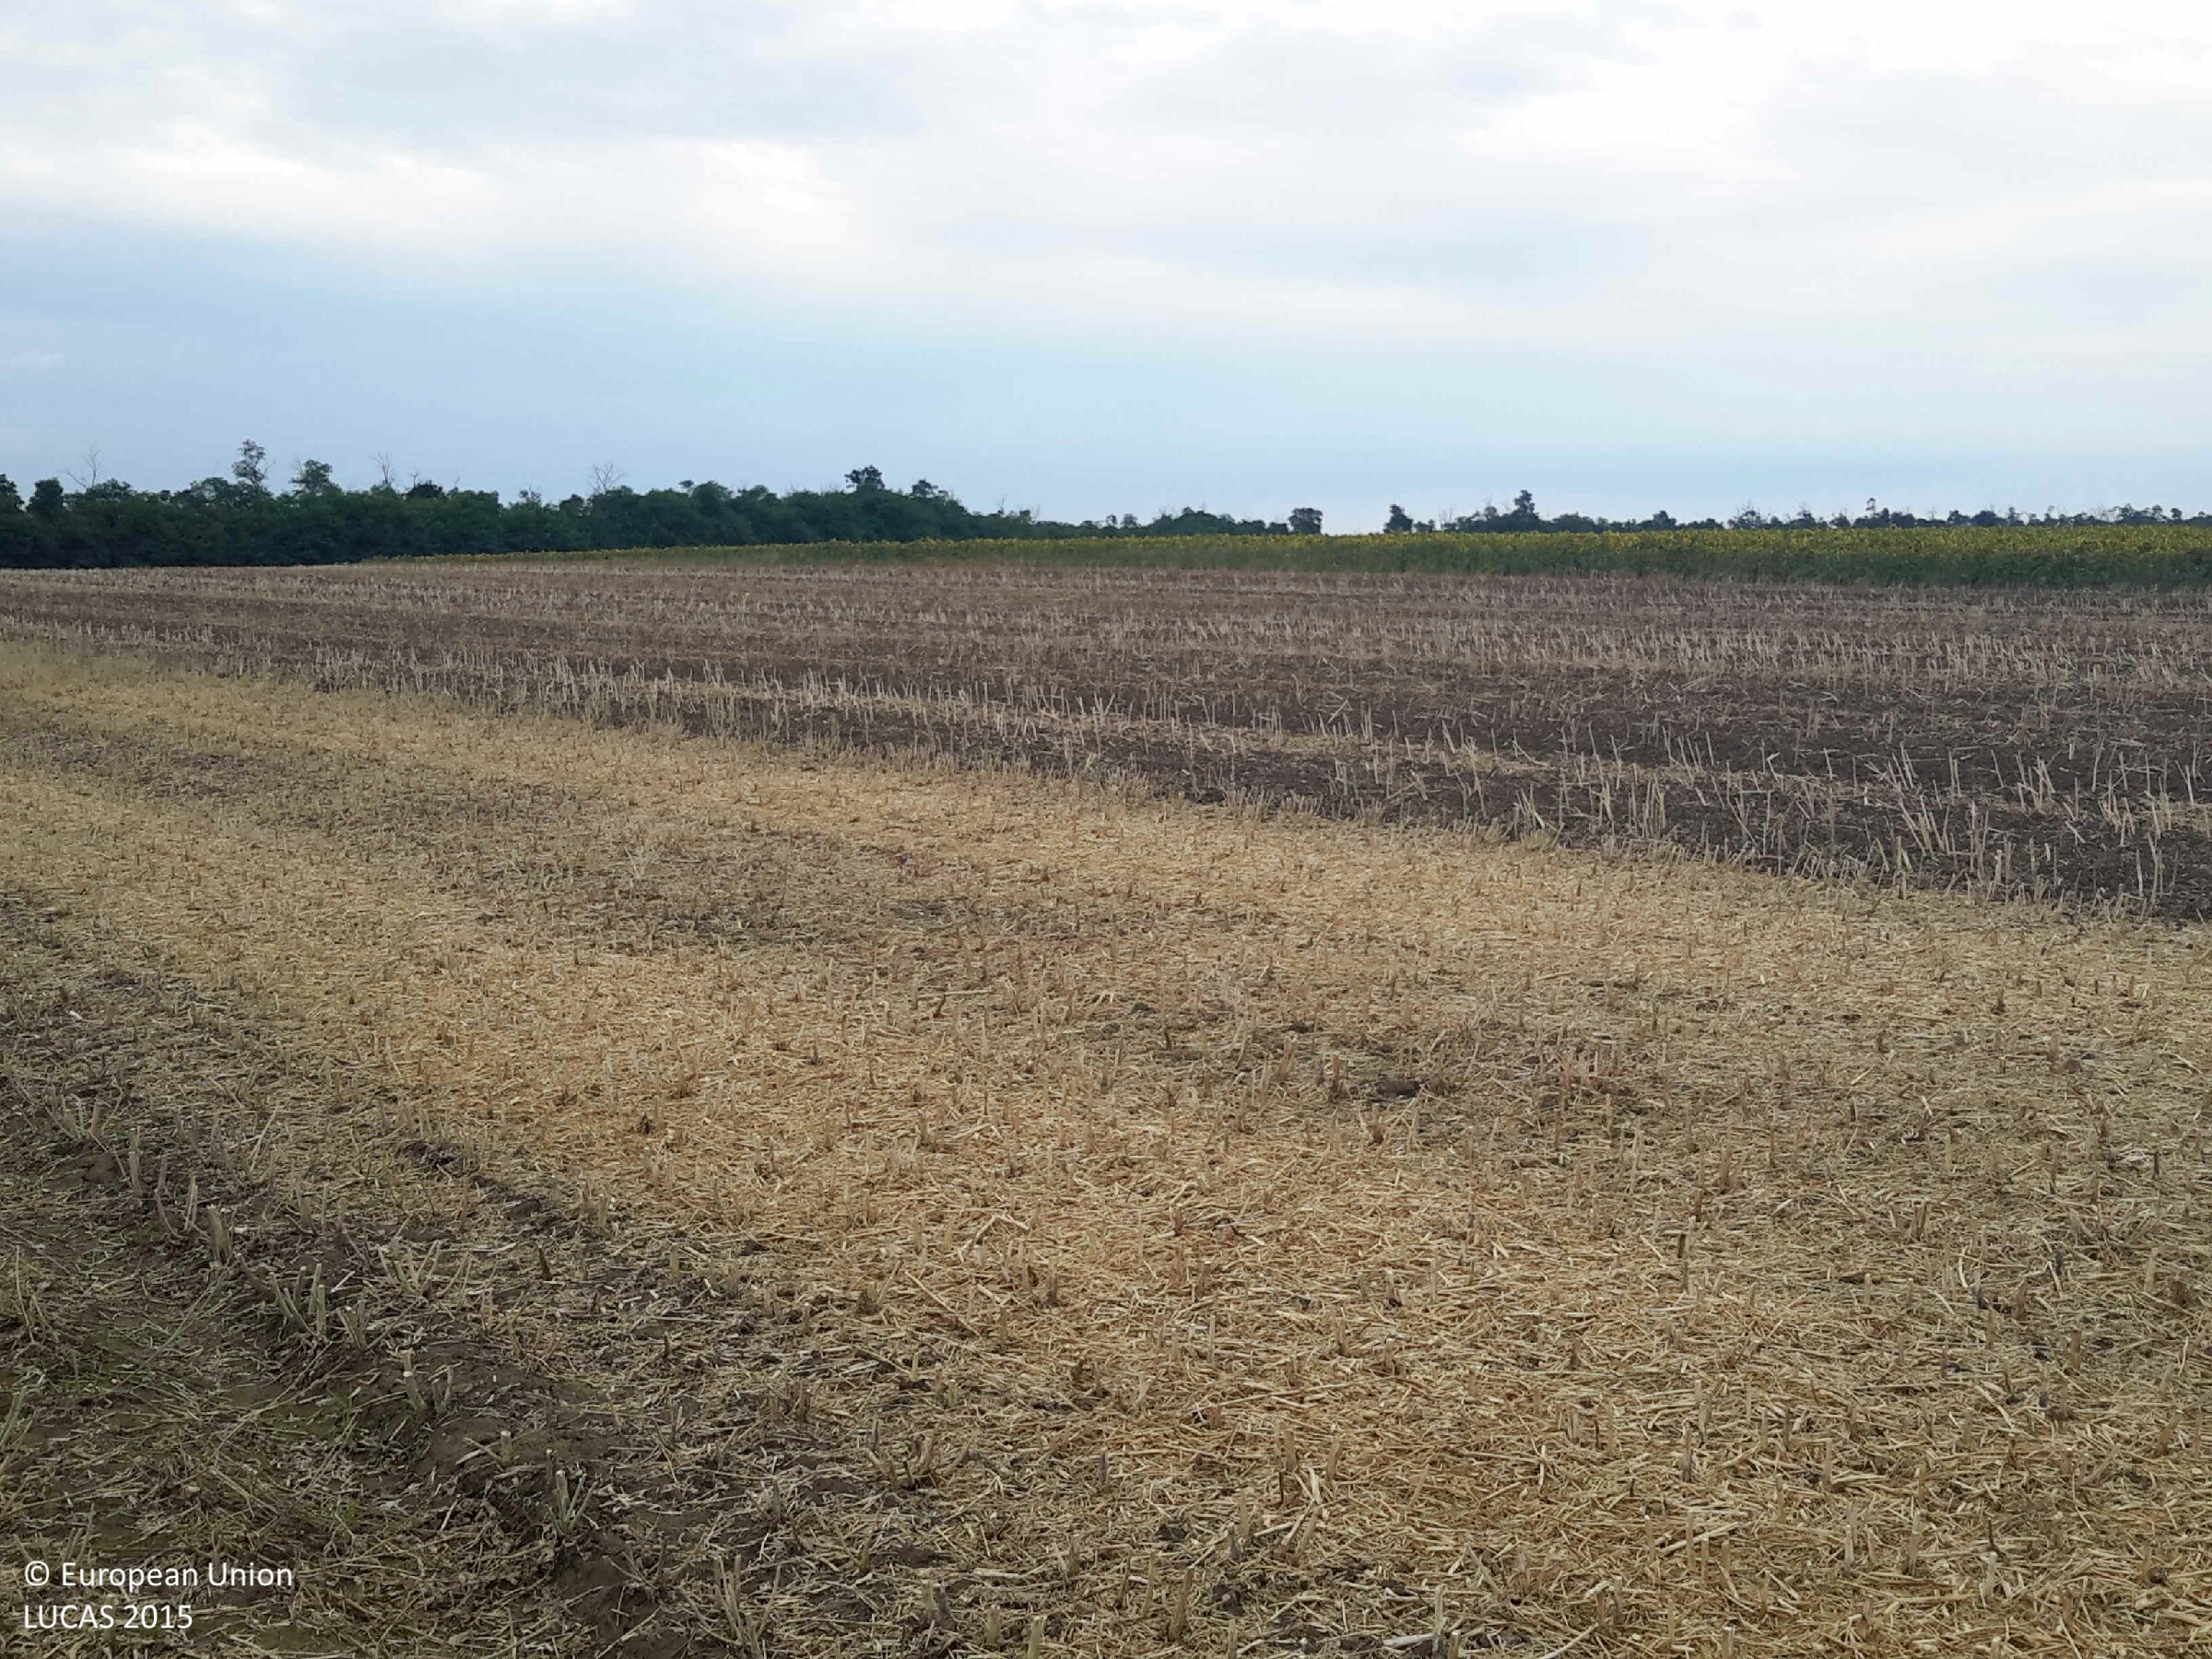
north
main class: Cropland
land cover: Rape and turnip rape
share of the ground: 10 - 25 %
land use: Agriculture (excluding fallow land and kitchen gardens)
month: July
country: HU
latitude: 47.4472
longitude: 17.1811
